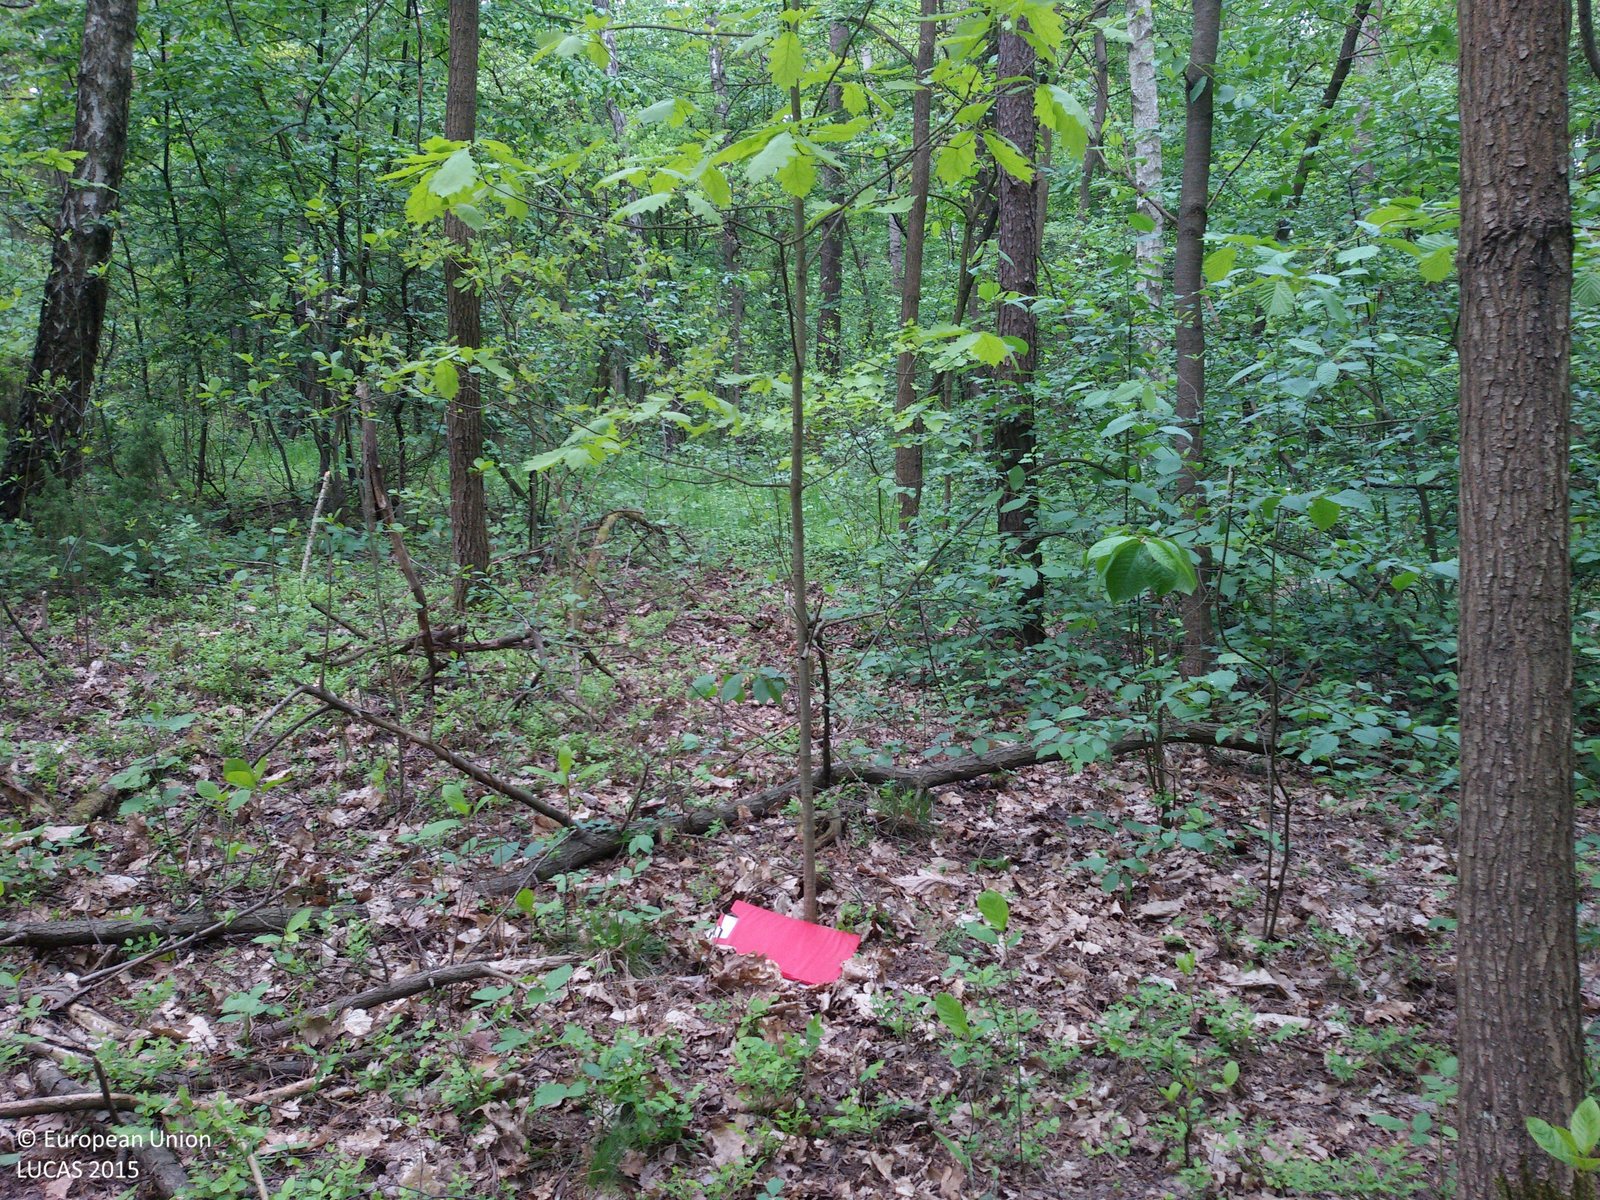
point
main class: Woodland
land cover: Pine dominated mixed woodland
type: hemiboreal forest and nemoral coniferous forest and mixed broadleaved-coniferous forest
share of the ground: > 75 %
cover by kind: coniferous forest trees 60 %, broadleaved forest trees 40 %
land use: Forestry
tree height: > 5 m
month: May
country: PL
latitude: 51.8701
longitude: 20.7452
